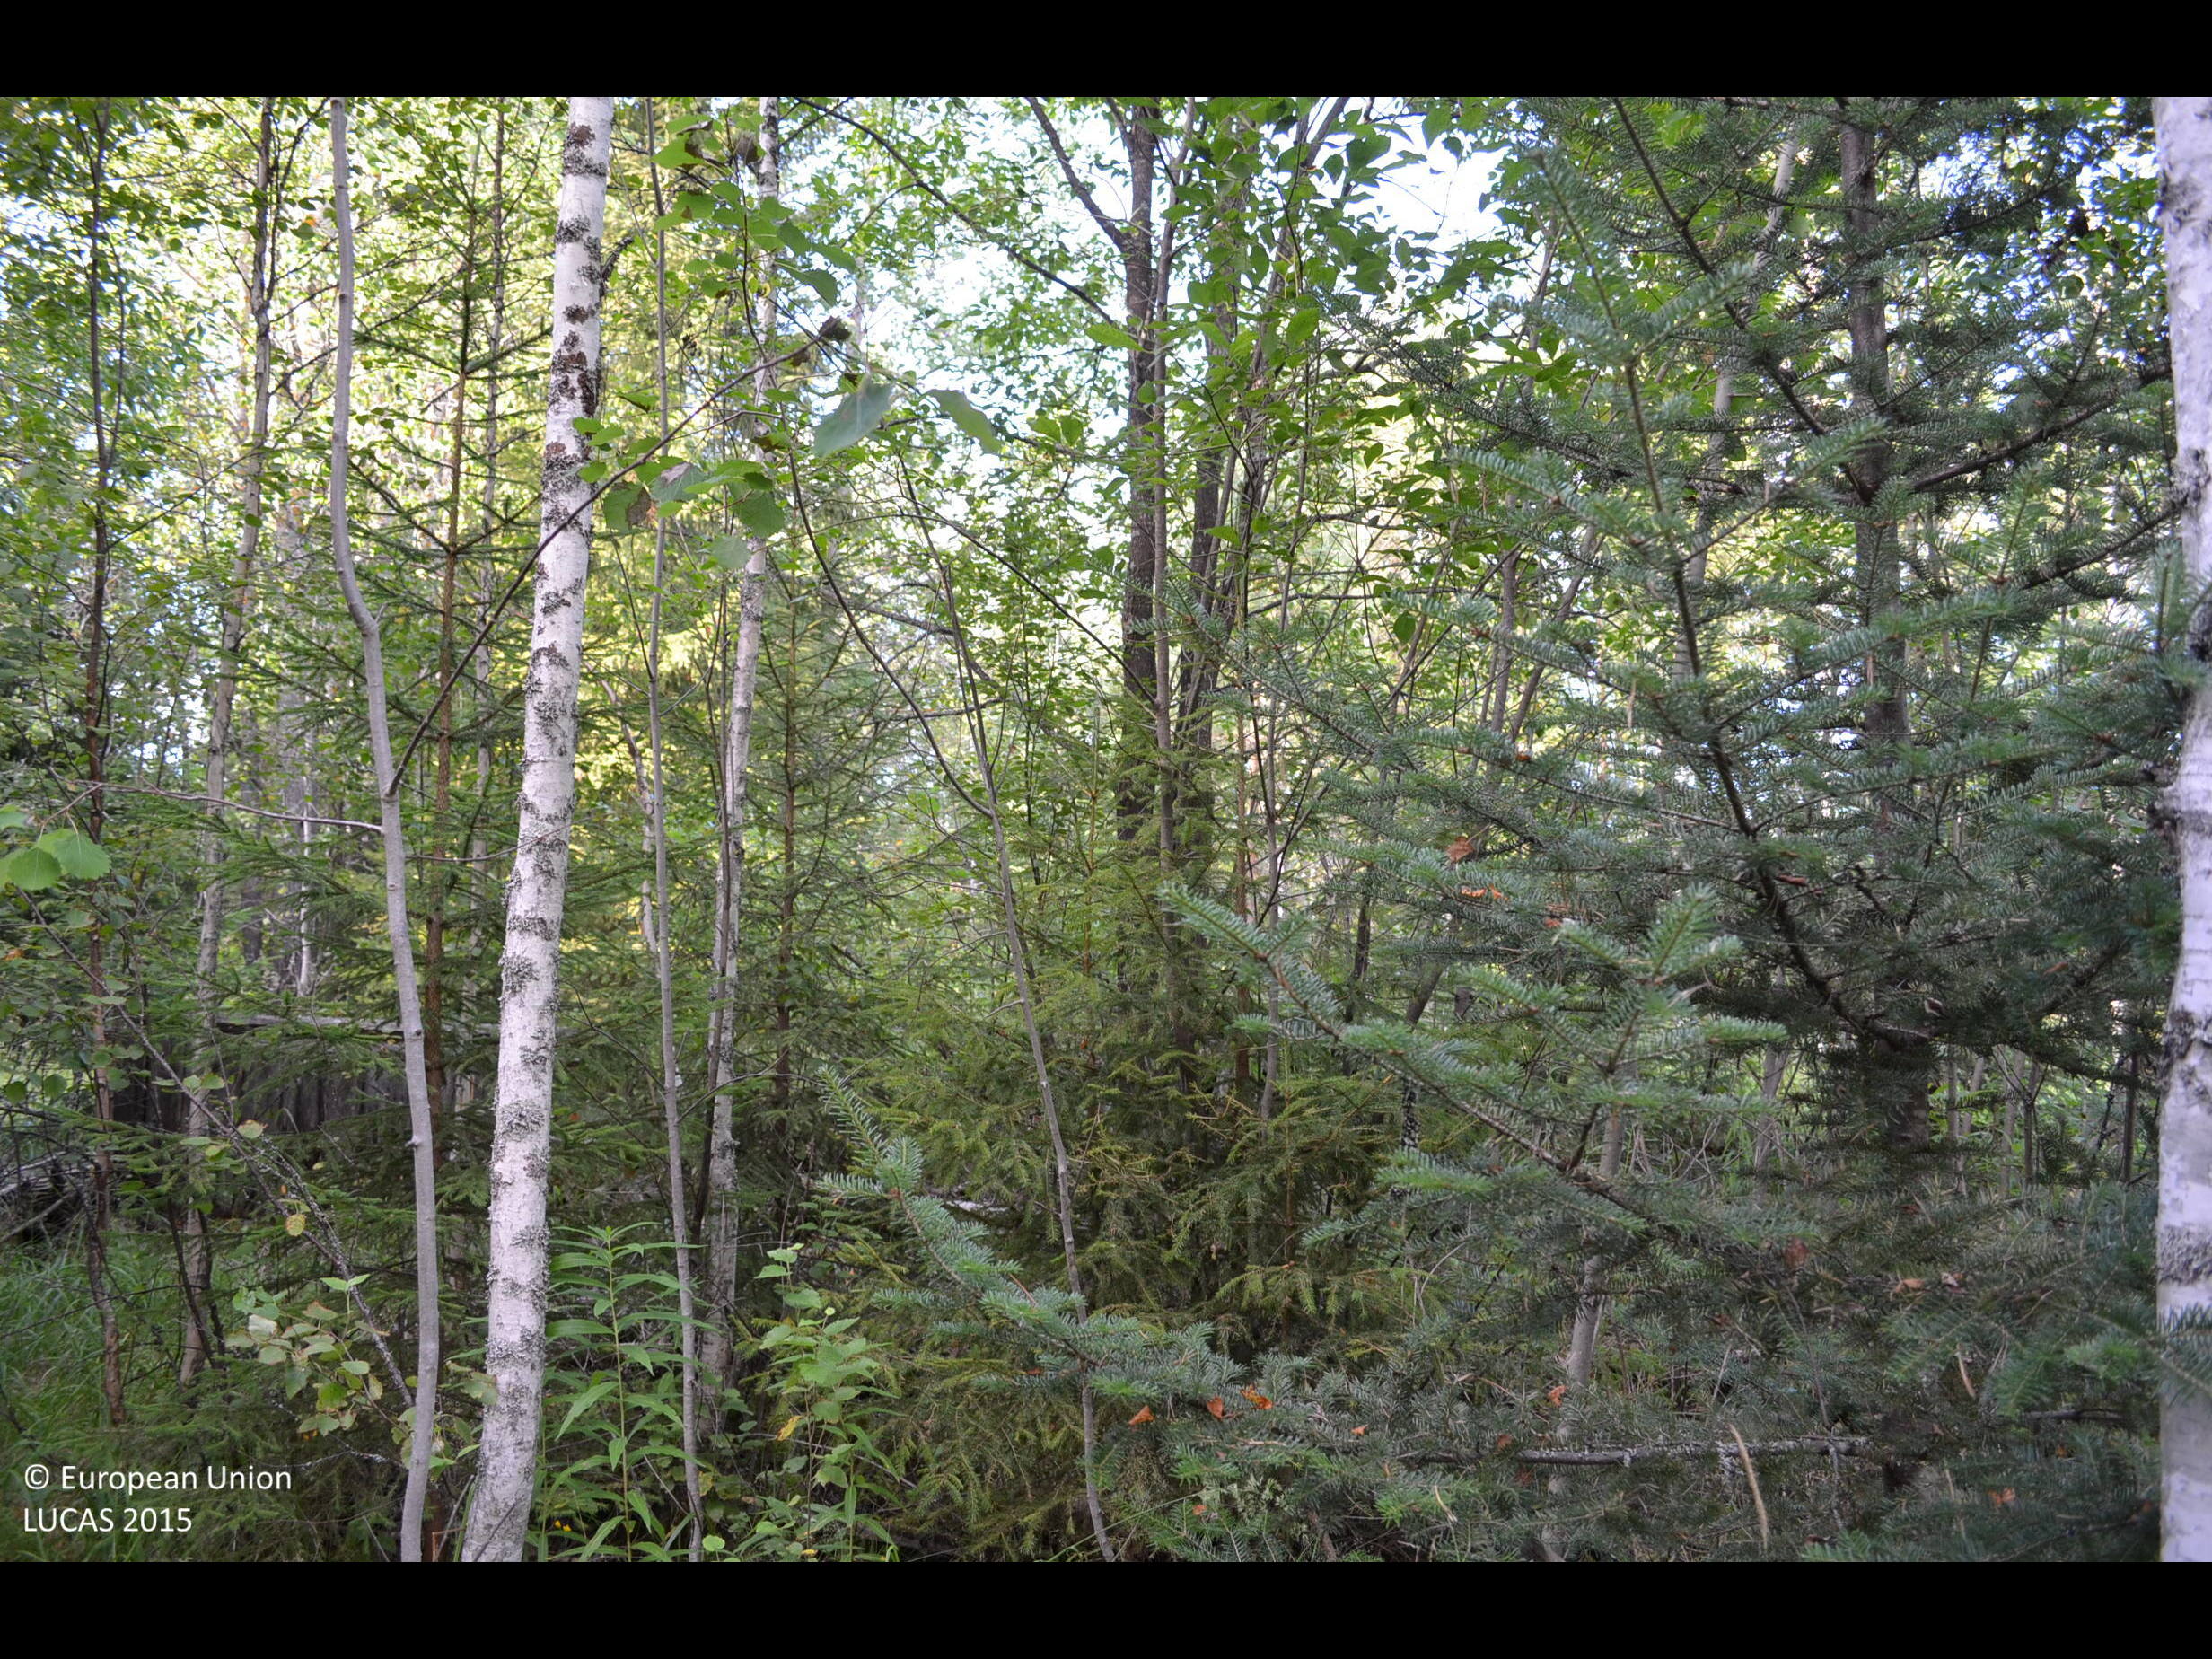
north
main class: Woodland
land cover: Spruce dominated mixed woodland
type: boreal forest
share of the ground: 50 - 75 %
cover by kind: coniferous forest trees 30 %, broadleaved forest trees 30 %, shrubs 25 %, herbaceous plants 15 %
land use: Forestry
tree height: > 5 m
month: August
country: FI
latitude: 62.3383
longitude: 24.3964
